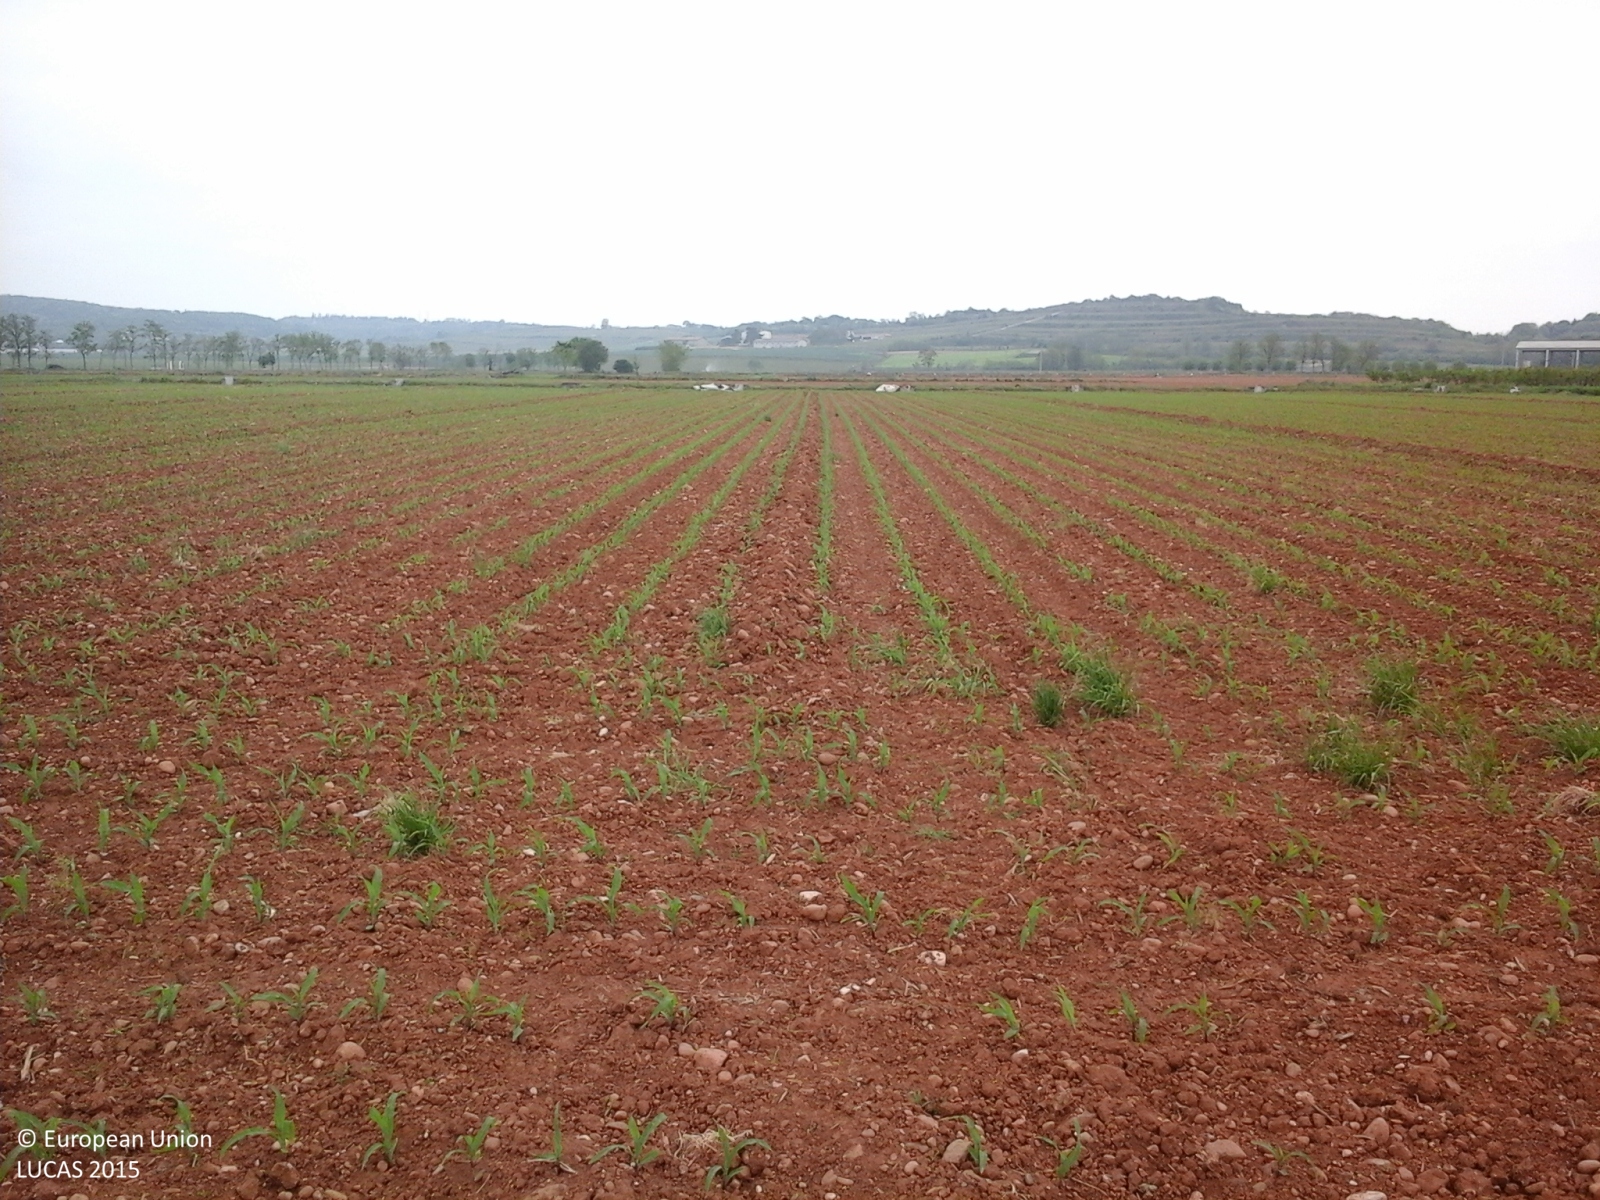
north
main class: Cropland
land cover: Maize
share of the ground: < 10 %
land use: Agriculture (excluding fallow land and kitchen gardens)
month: April
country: IT
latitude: 45.3223
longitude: 10.6240
